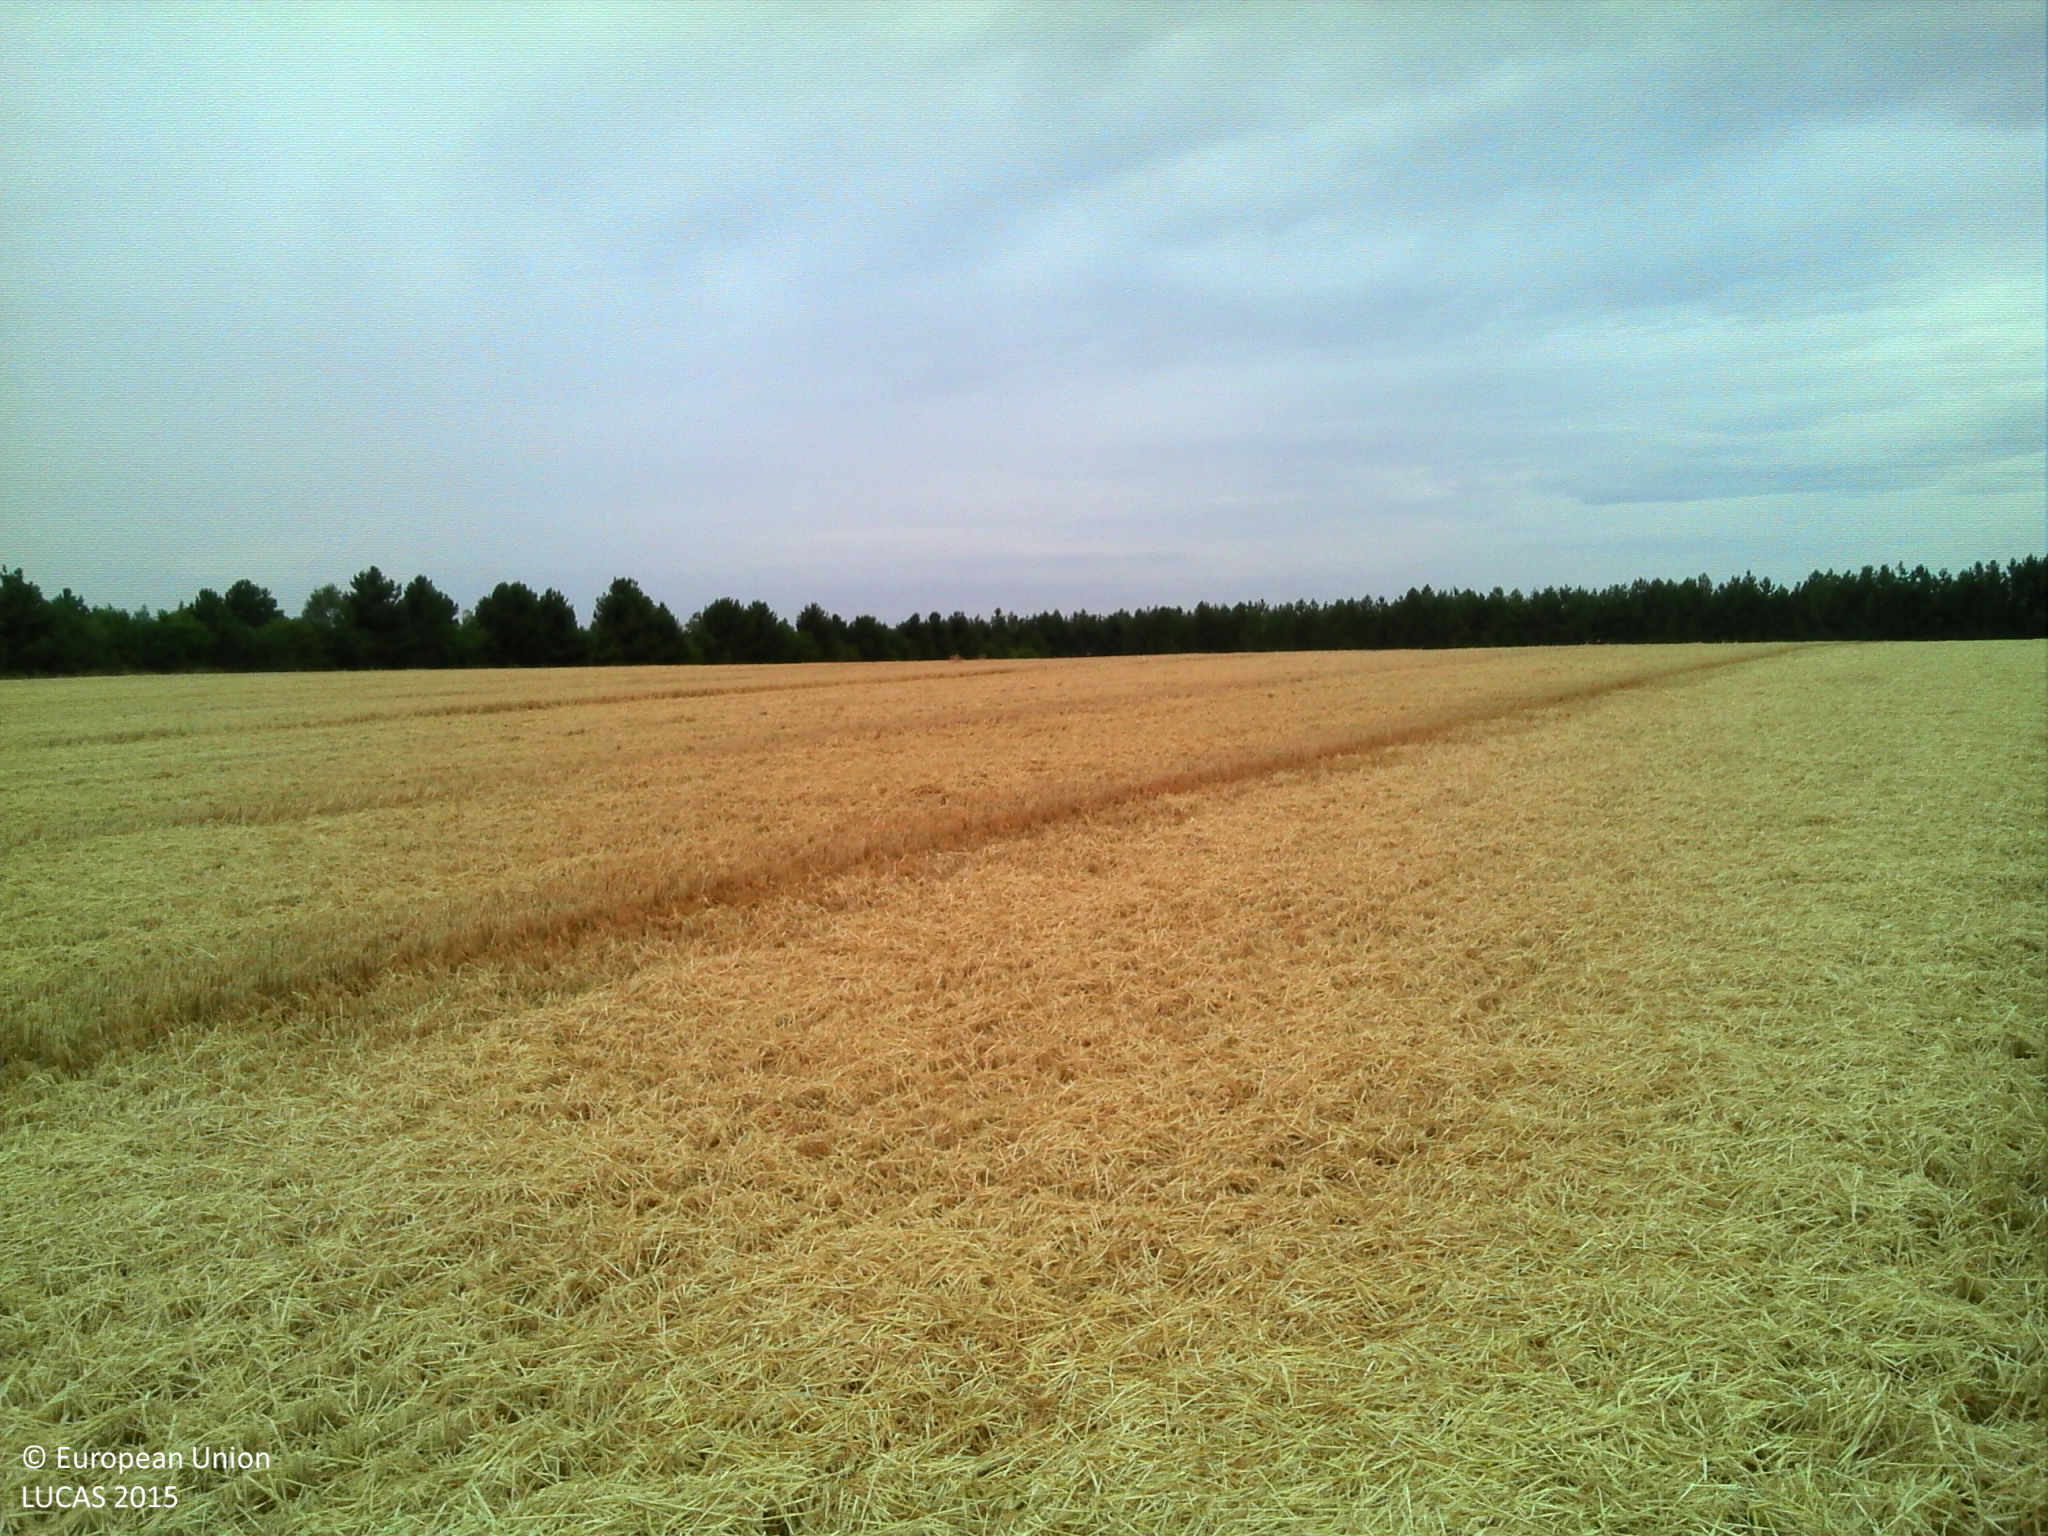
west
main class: Cropland
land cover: Rye
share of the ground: > 75 %
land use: Agriculture (excluding fallow land and kitchen gardens)
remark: Harvested field
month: July
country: FR
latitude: 49.2246
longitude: 4.1874
